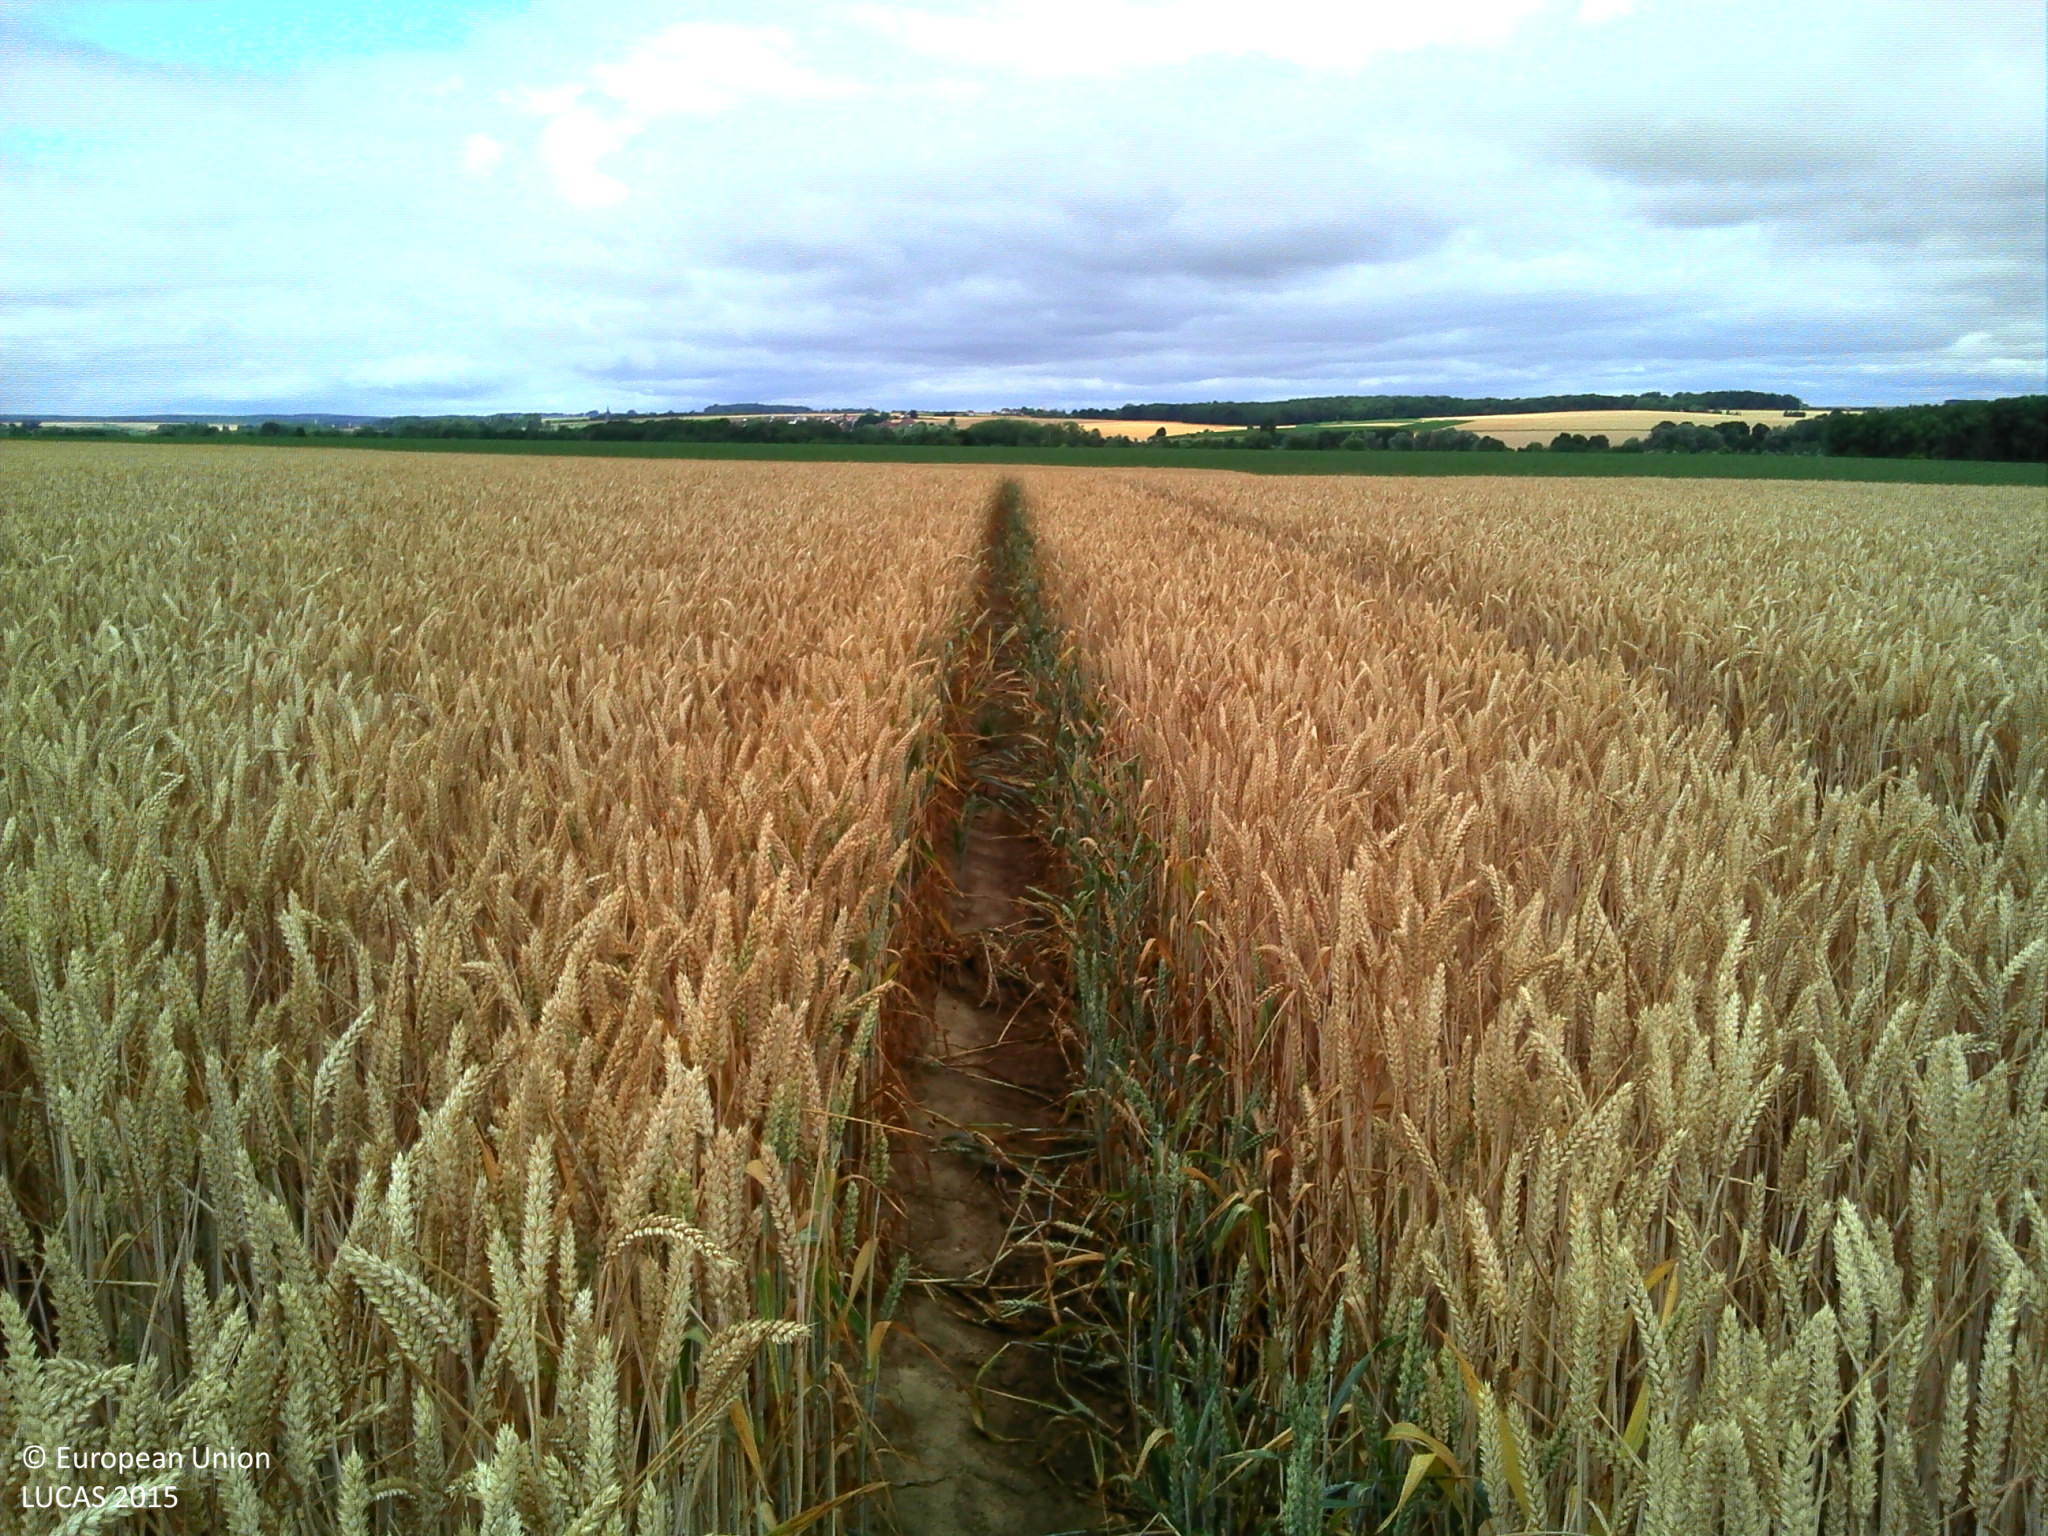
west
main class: Cropland
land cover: Common wheat
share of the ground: > 75 %
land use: Agriculture (excluding fallow land and kitchen gardens)
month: July
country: FR
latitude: 50.1260
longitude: 3.2071
